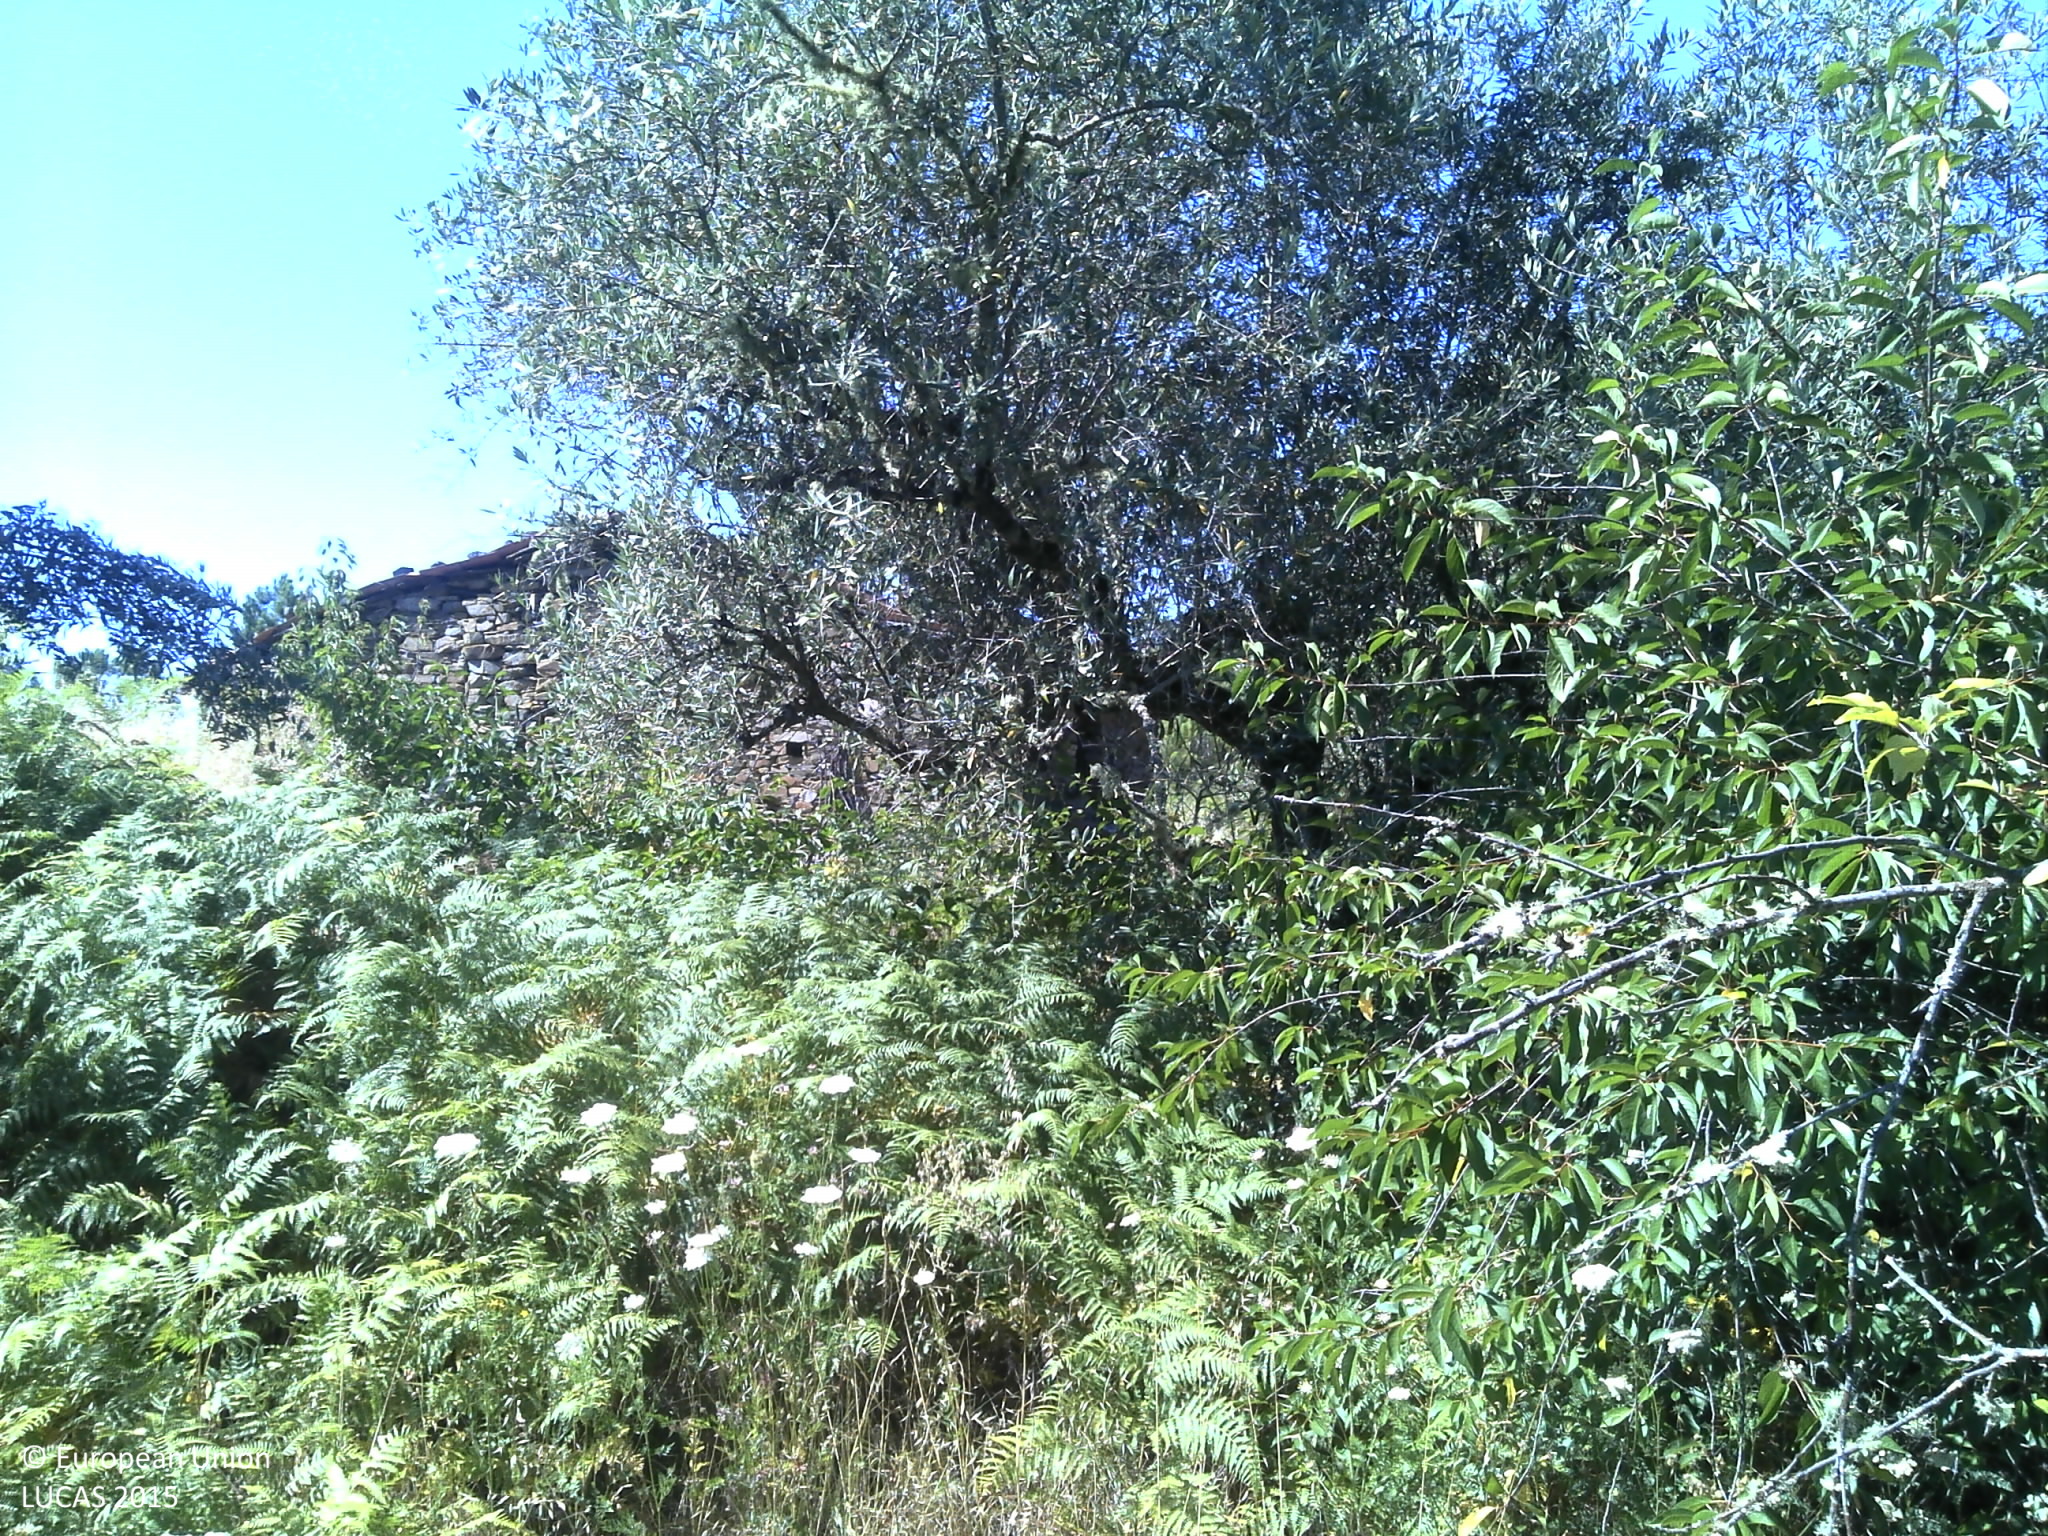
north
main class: Shrubland
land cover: Shrubland with sparse tree cover
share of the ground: > 75 %
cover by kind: shrubs 80 %, consolidated bare surface 10 %, broadleaved forest trees 5 %, unconsolidated bare surface 5 %
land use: Abandoned areas
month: July
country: PT
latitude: 40.2802
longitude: -7.9371
